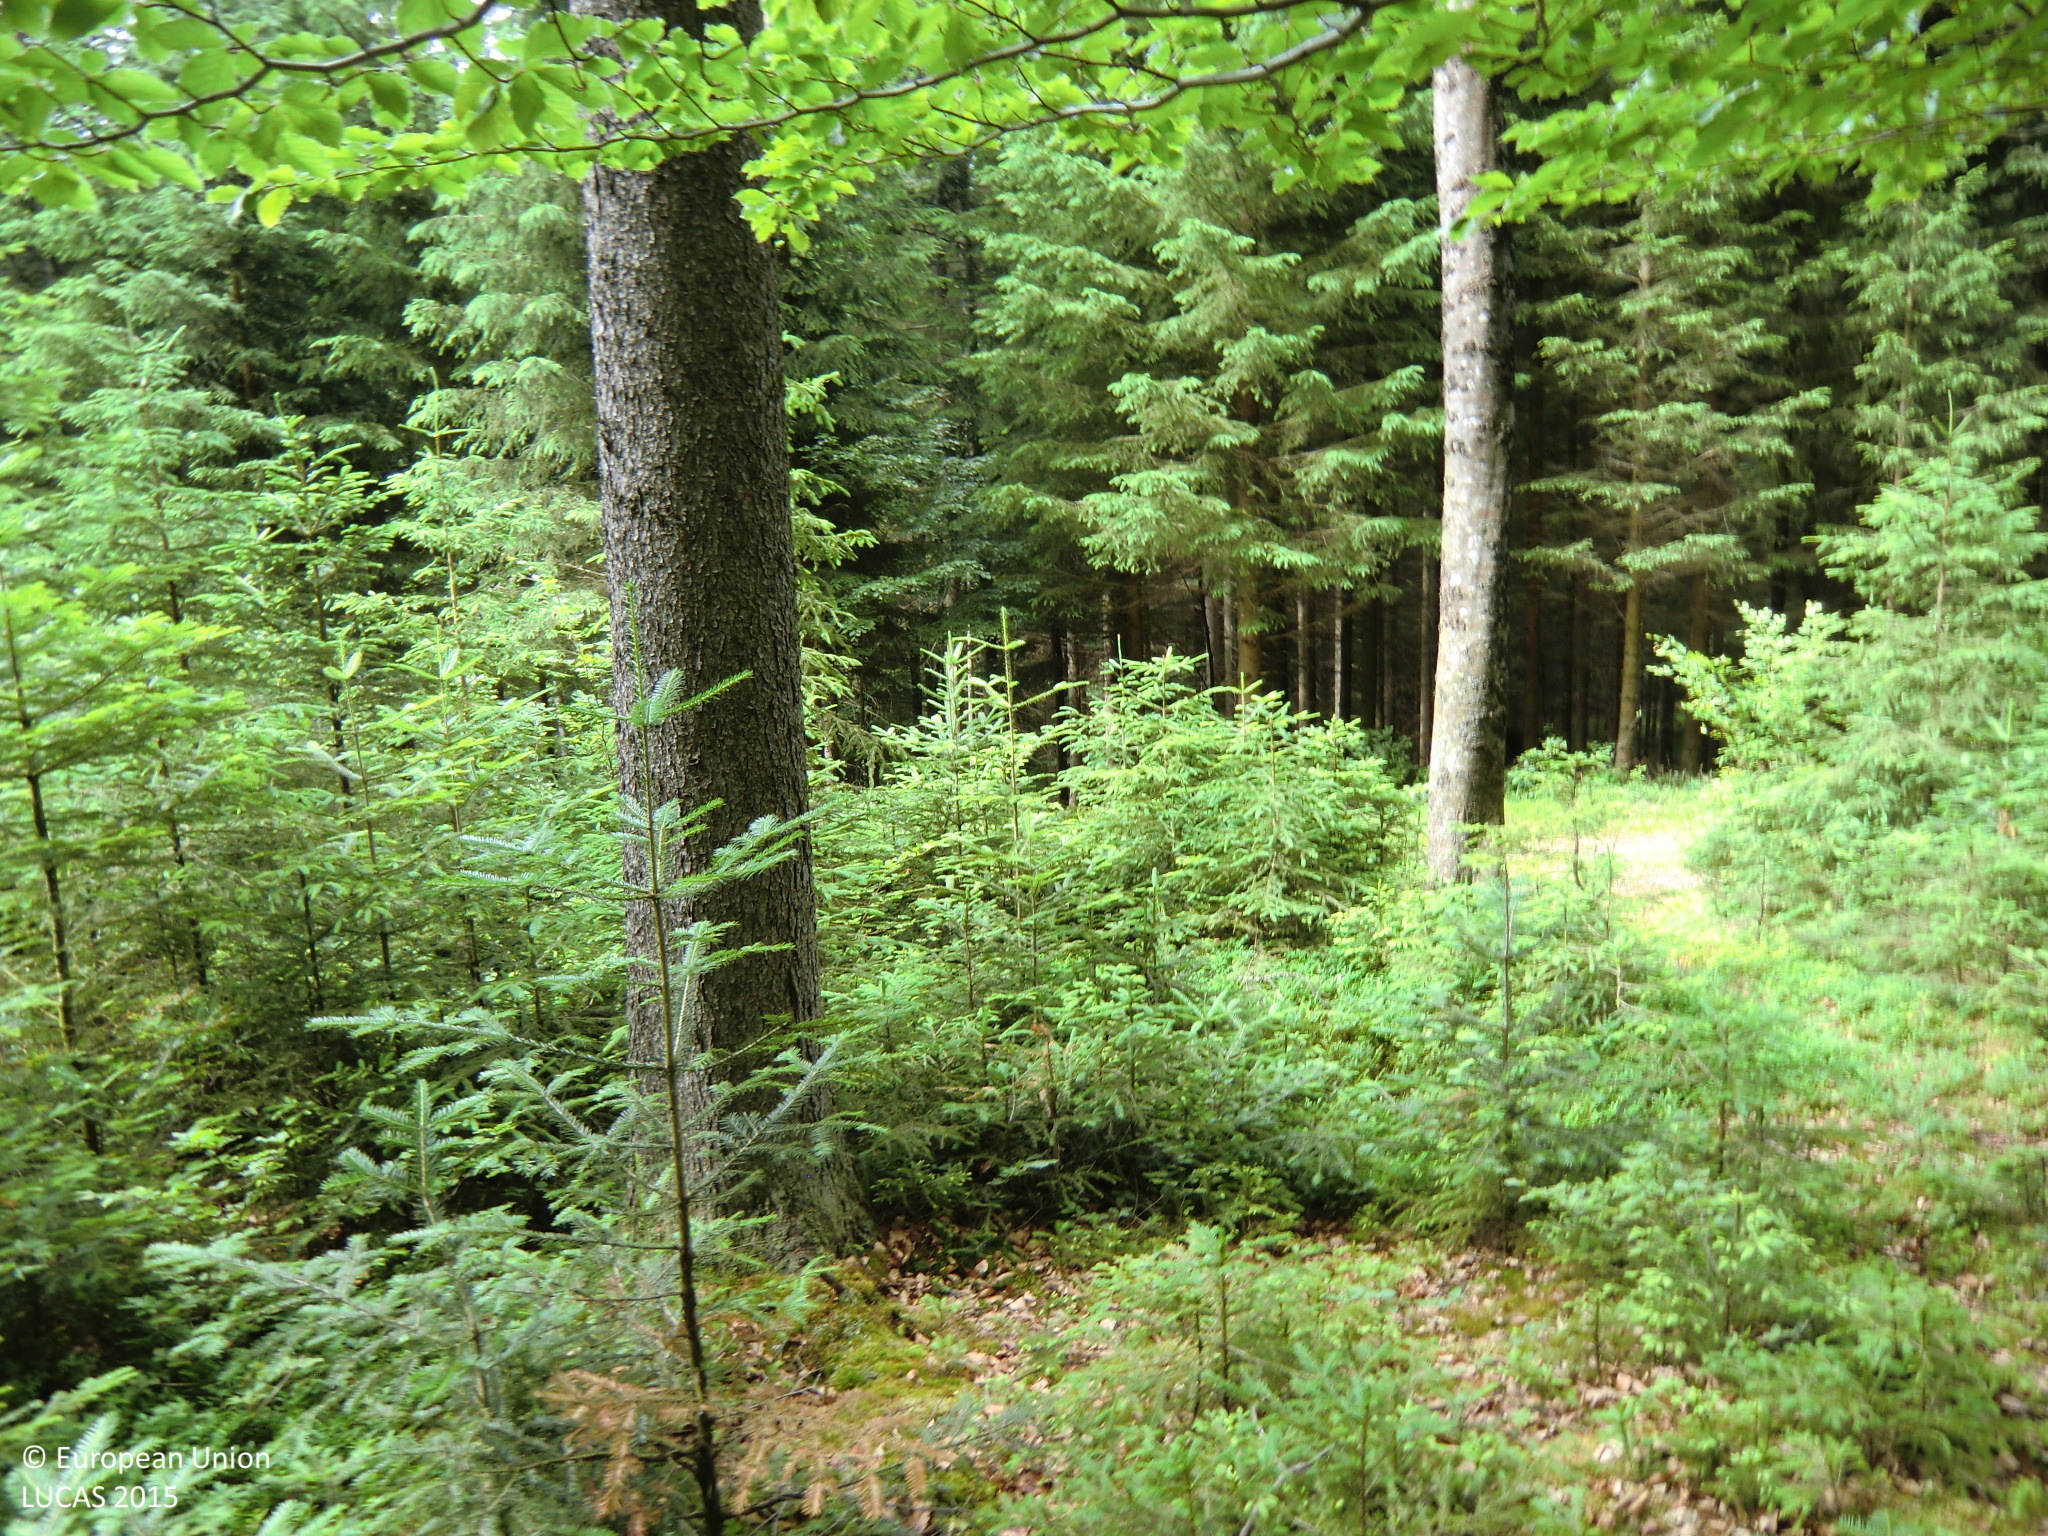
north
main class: Woodland
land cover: Spruce dominated mixed woodland
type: hemiboreal forest and nemoral coniferous forest and mixed broadleaved-coniferous forest
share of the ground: > 75 %
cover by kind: coniferous forest trees 45 %, broadleaved forest trees 45 %, herbaceous plants 5 %, unconsolidated bare surface 5 %
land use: Forestry
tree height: > 5 m
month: June
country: AT
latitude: 48.4531
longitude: 14.9909
